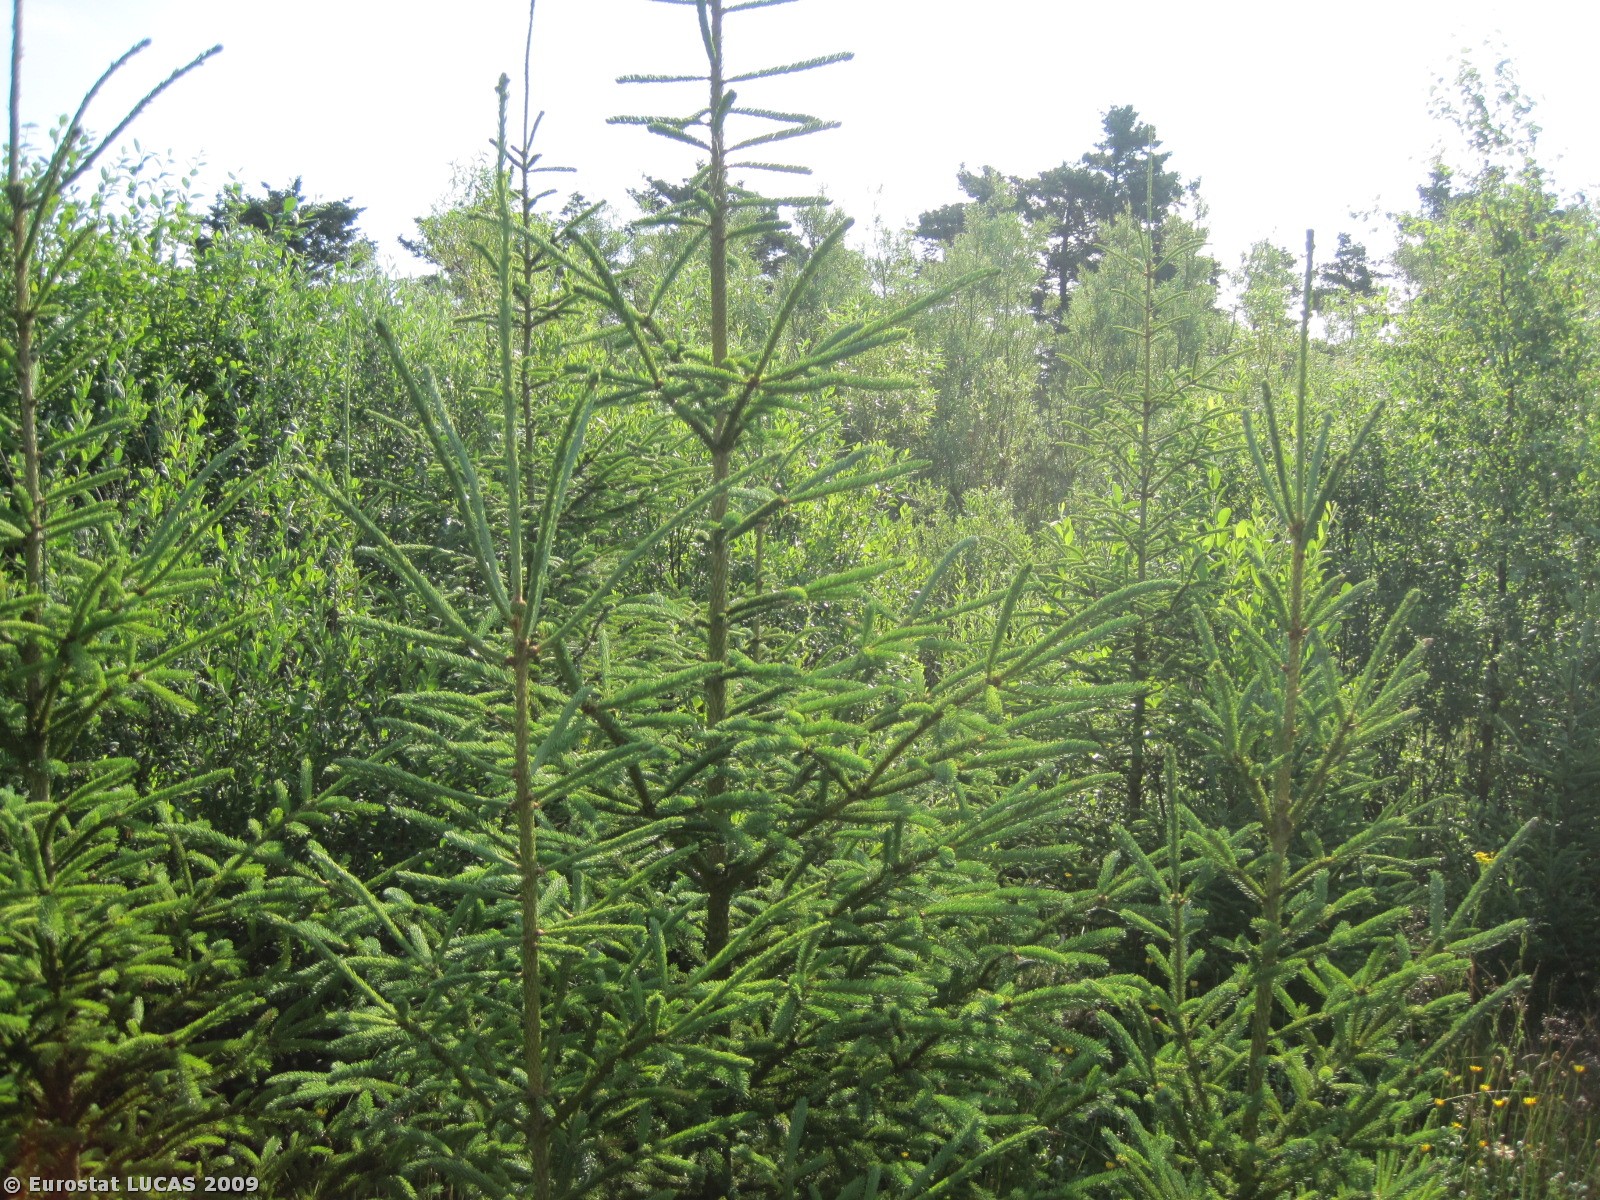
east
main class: Woodland
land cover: Mixed woodland
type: plantations and self-sown exotic forest
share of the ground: 25 - 50 %
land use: Forestry
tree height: > 5 m
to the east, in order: Mixed woodland; Grassland without tree/shrub cover; Mixed woodland; Grassland without tree/shrub cover; Coniferous woodland; Grassland without tree/shrub cover; Mixed woodland; Grassland without tree/shrub cover; Coniferous woodland
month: July
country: DK
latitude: 56.4873
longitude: 8.7511
